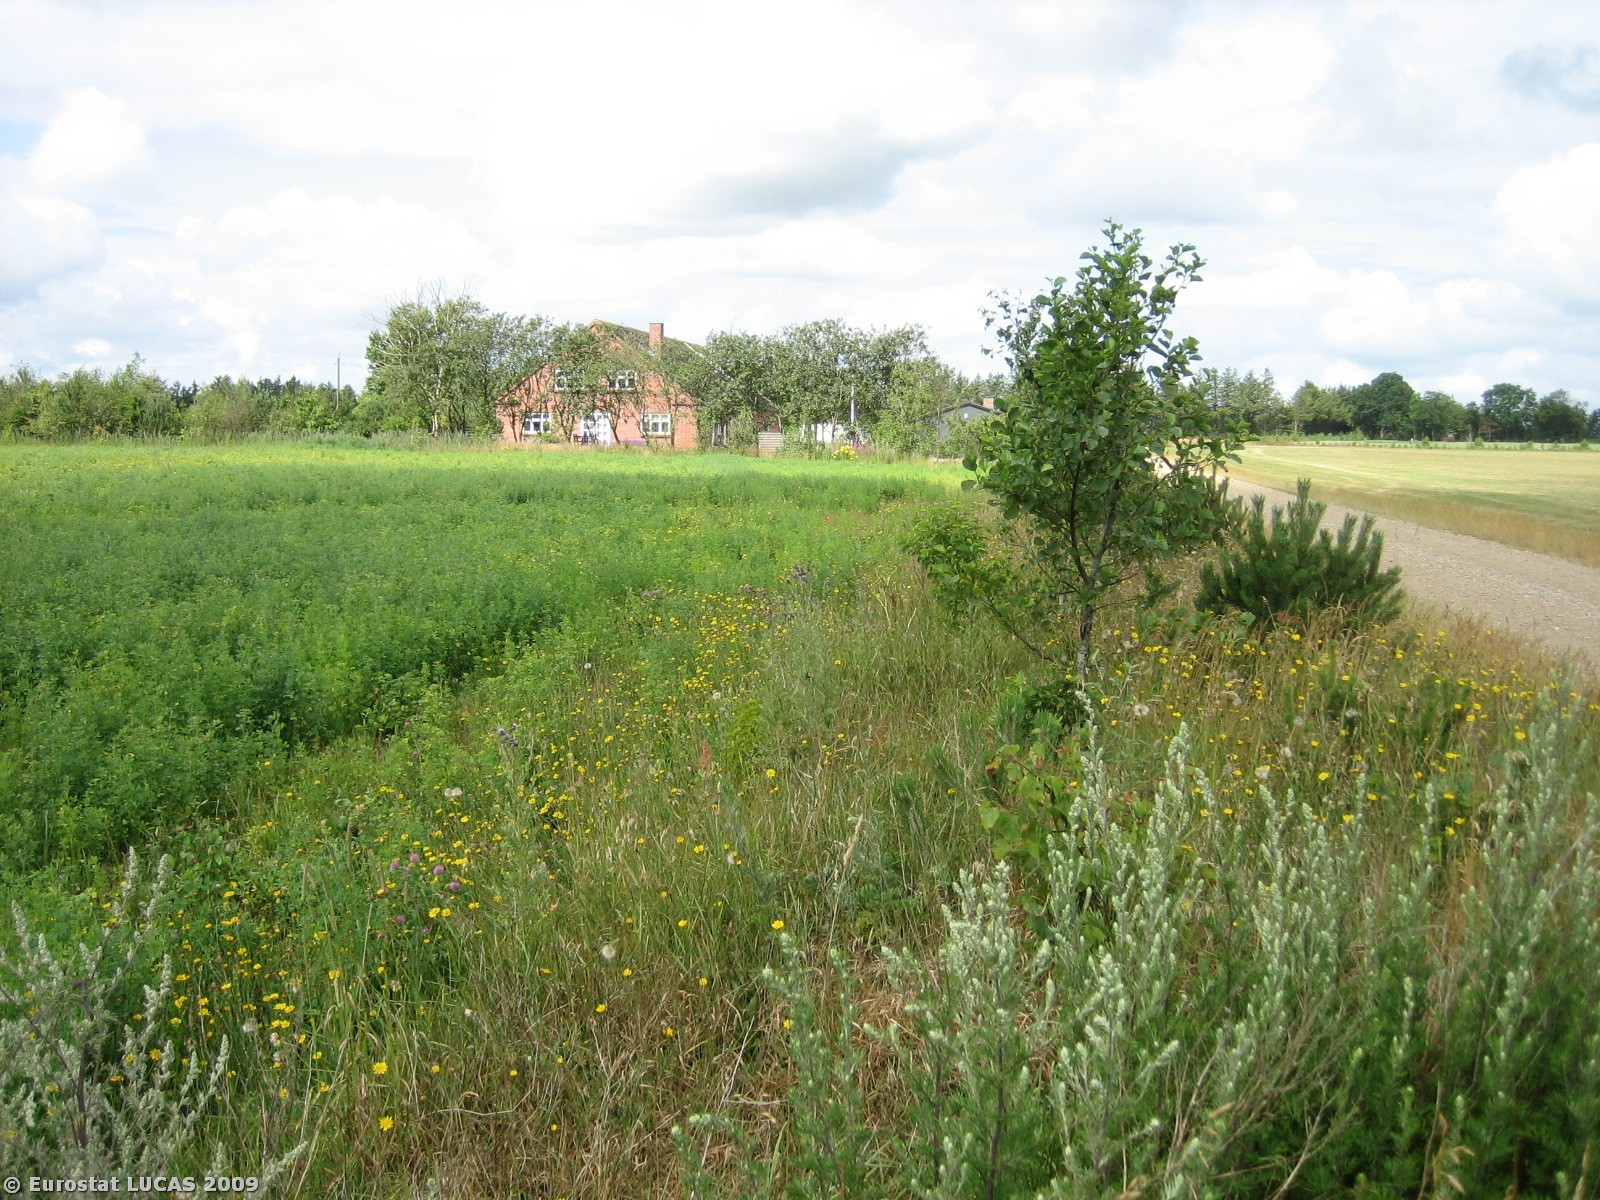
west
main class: Cropland
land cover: Clovers
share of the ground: > 75 %
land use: Agriculture (excluding fallow land and kitchen gardens)
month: July
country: DK
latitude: 55.8372
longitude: 8.4846
